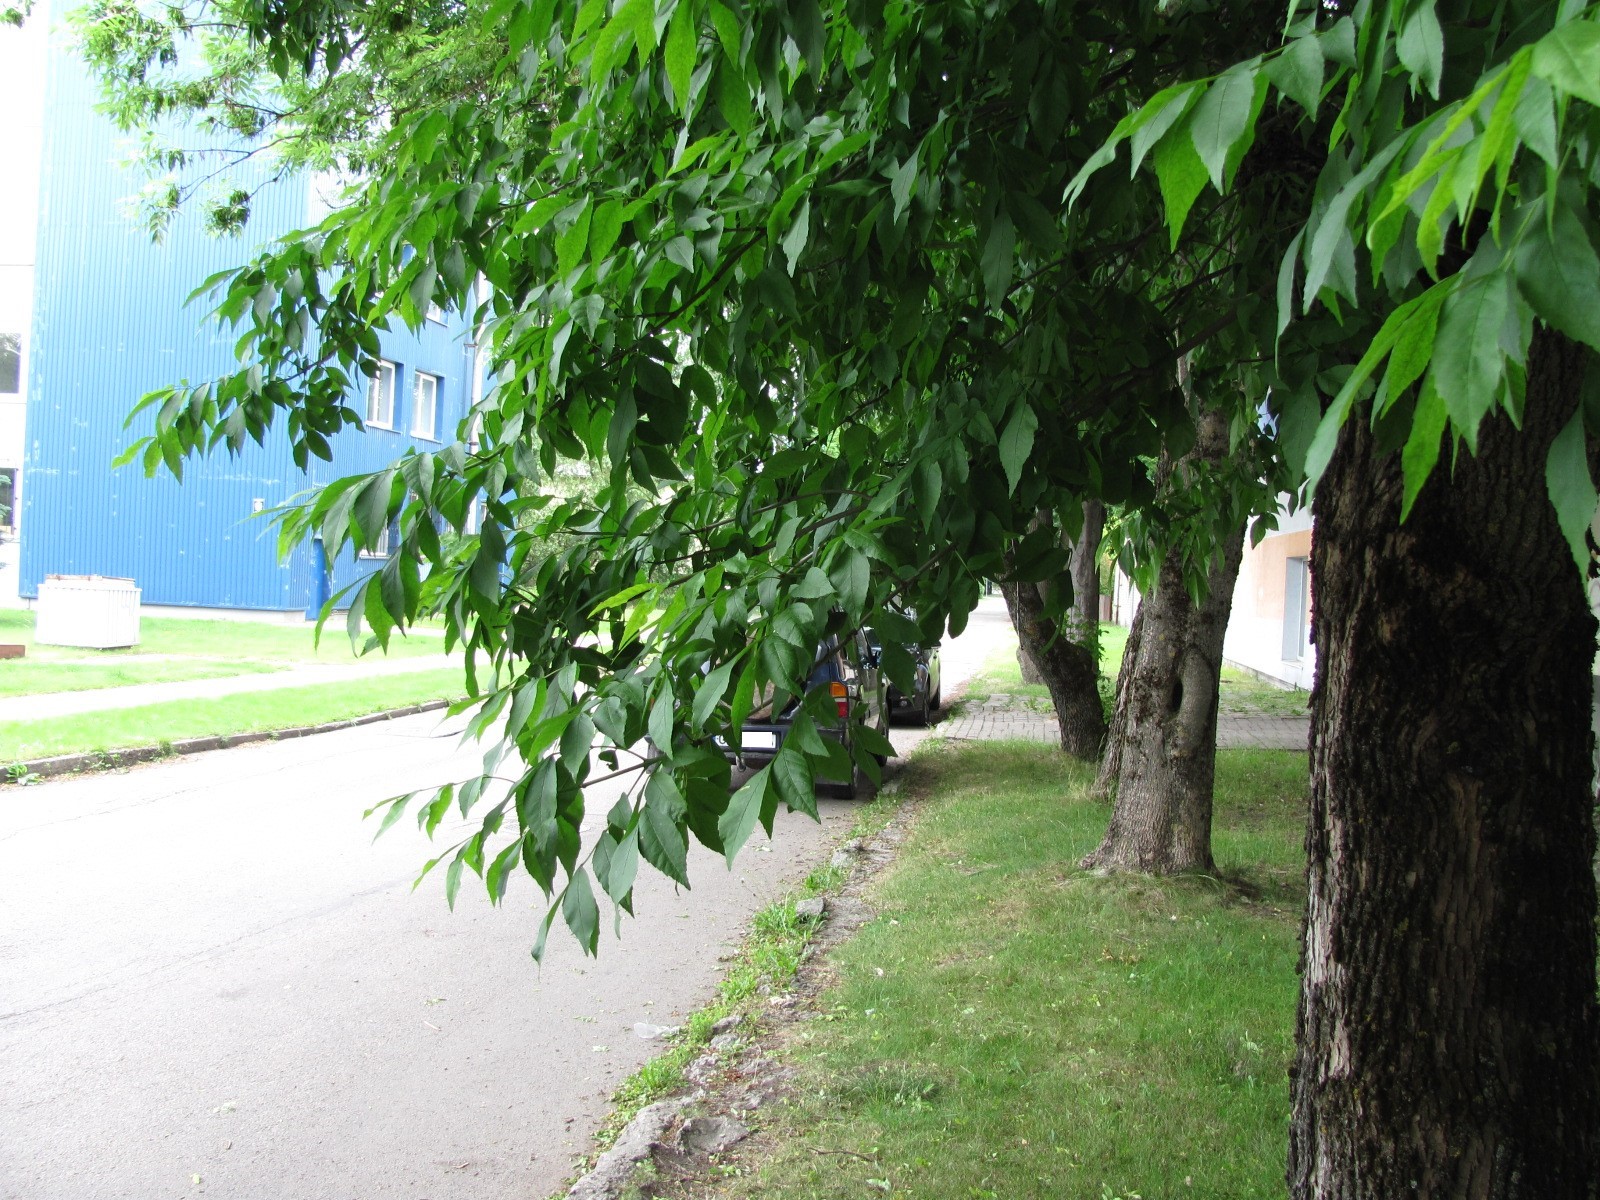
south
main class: Woodland
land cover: Broadleaved woodland
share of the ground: > 75 %
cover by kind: broadleaved forest trees 100 %
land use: Residential
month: June
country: LV
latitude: 56.9501
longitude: 24.1764
